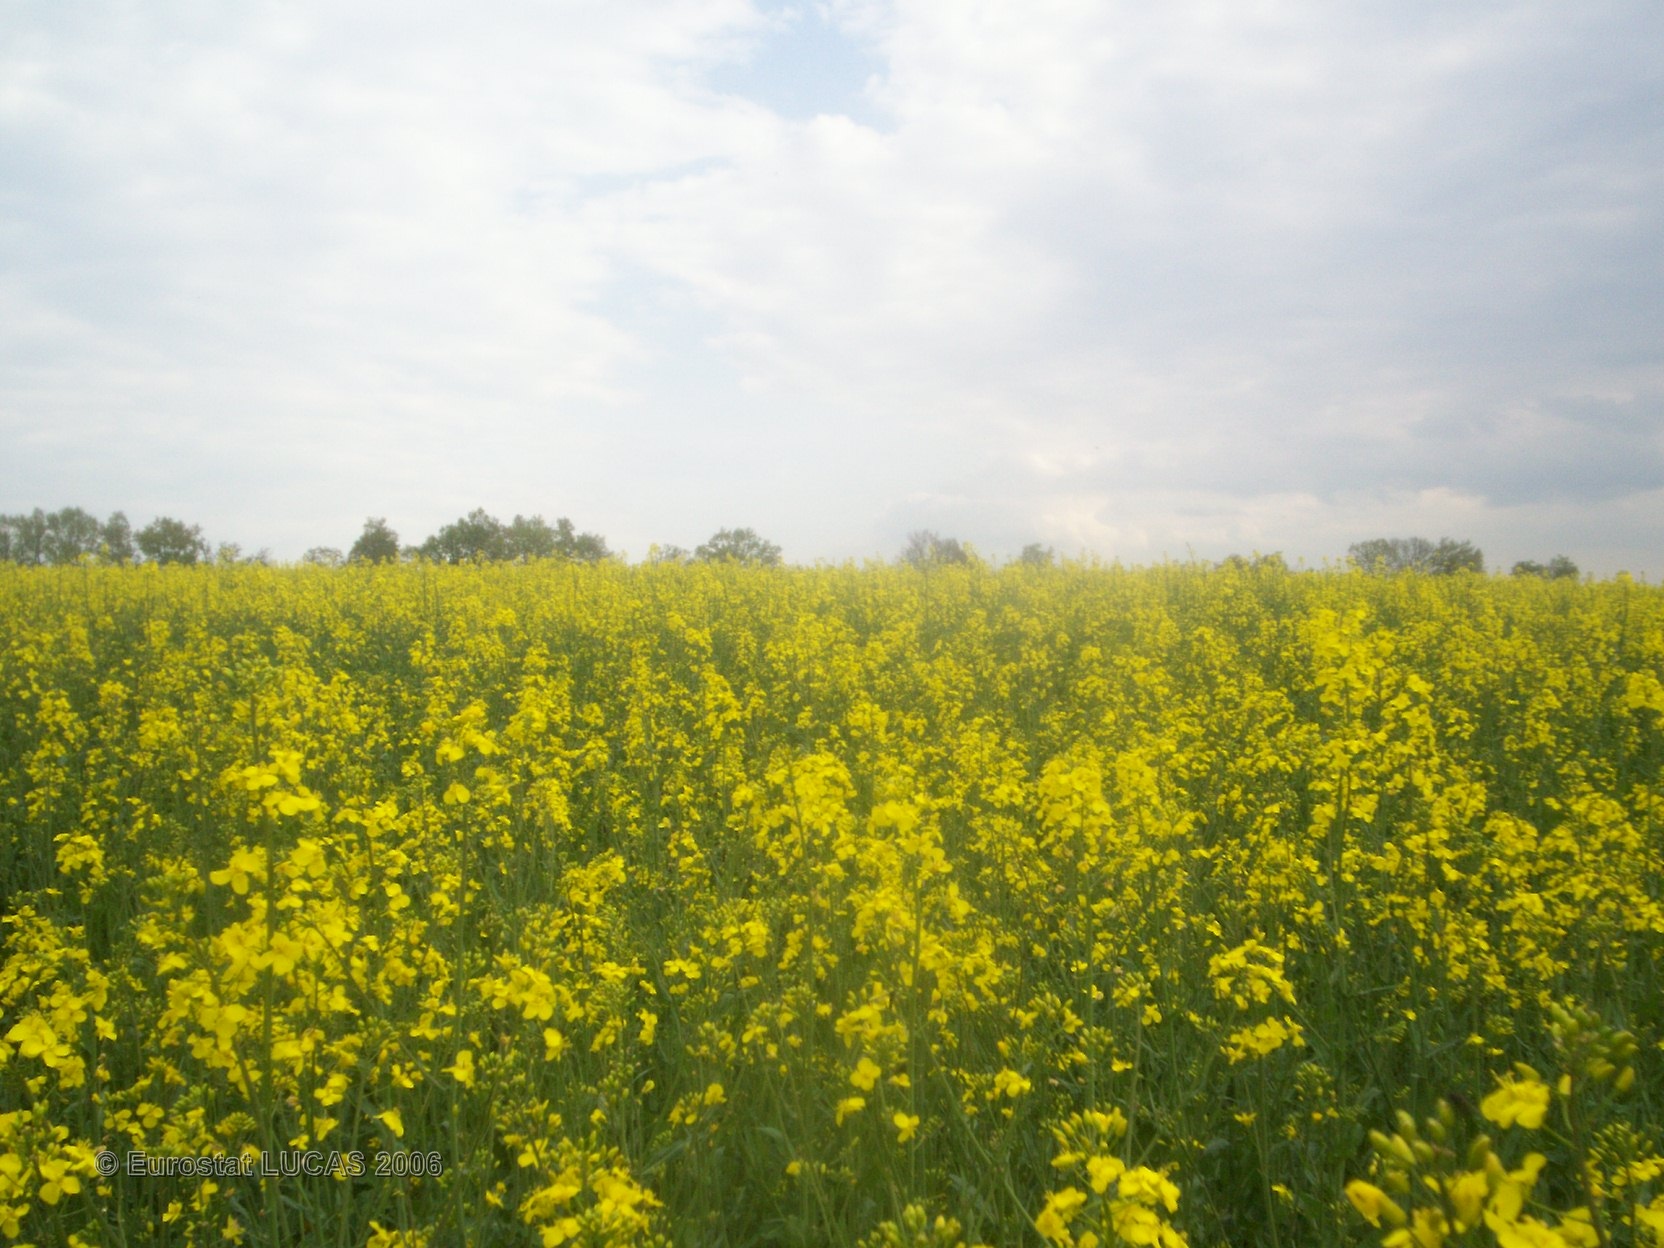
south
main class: Cropland
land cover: Rape and turnip rape
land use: Agriculture (excluding fallow land and kitchen gardens)
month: May
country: FR
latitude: 46.4705
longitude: 3.0822
